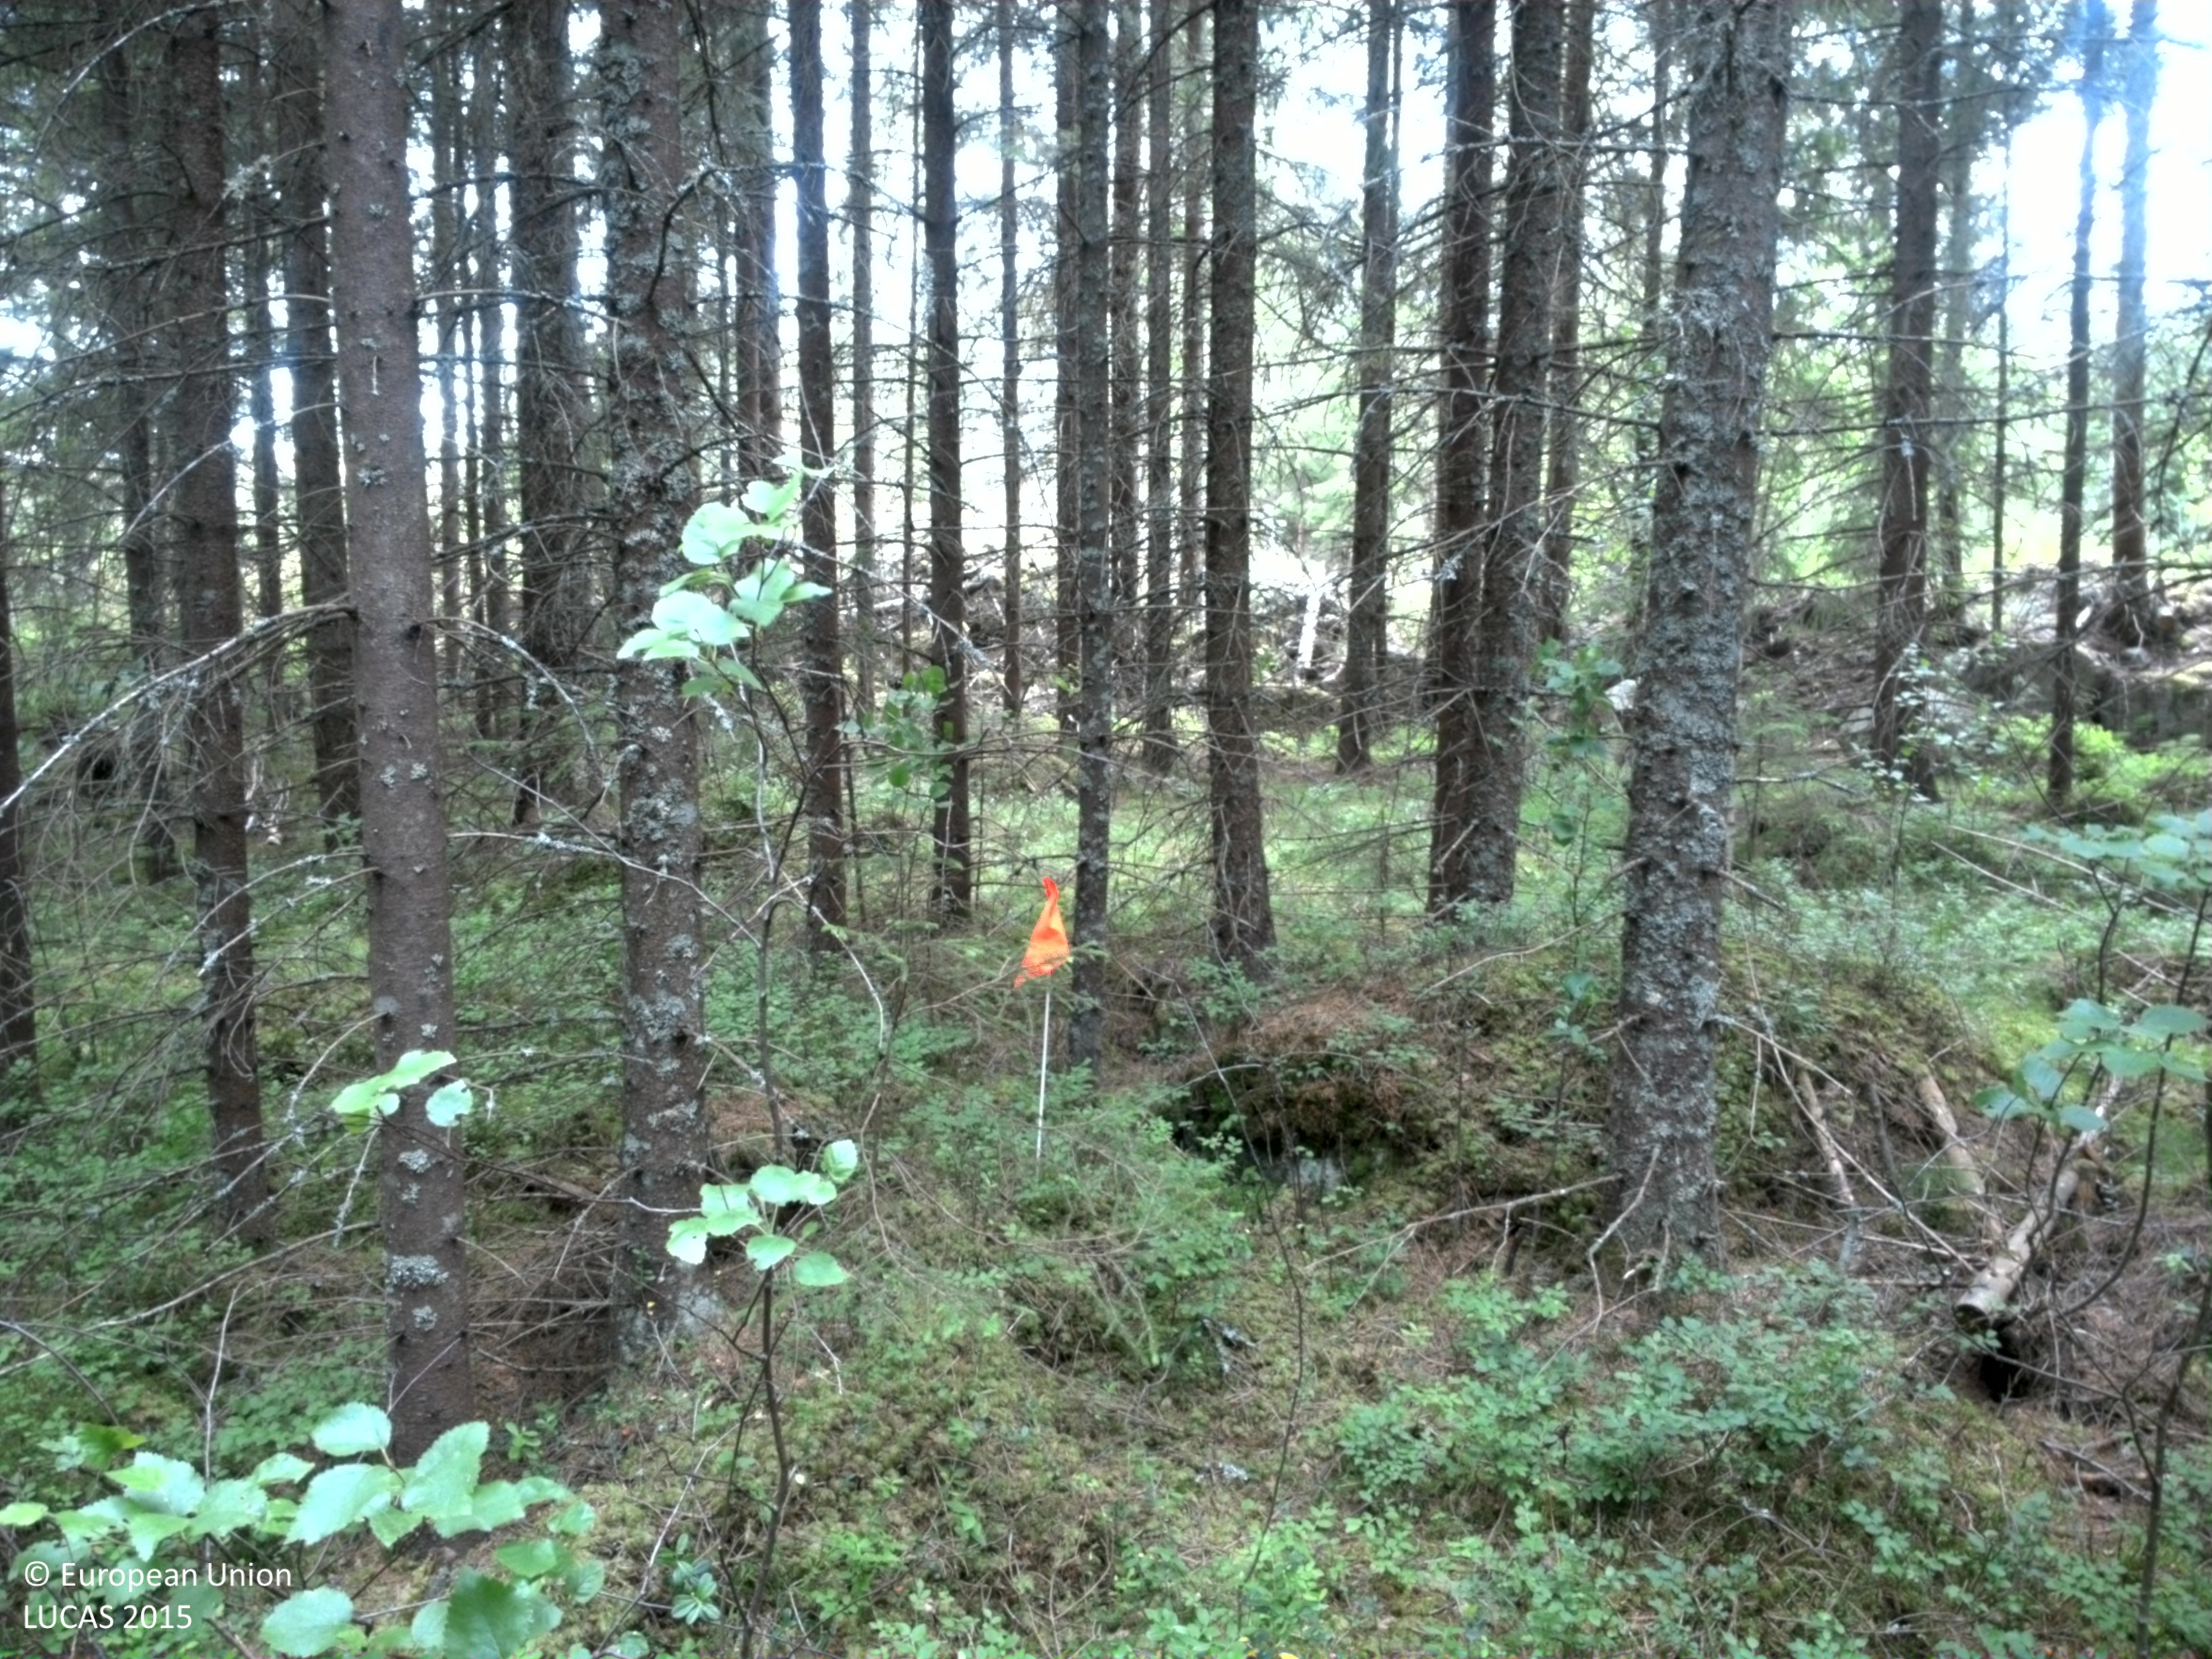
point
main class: Woodland
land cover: Spruce dominated mixed woodland
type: boreal forest
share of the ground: > 75 %
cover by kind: coniferous forest trees 60 %, broadleaved forest trees 20 %, shrubs 10 %, lichens and mosses 10 %
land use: Forestry
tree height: > 5 m
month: July
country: SE
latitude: 59.5656
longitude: 14.5747
